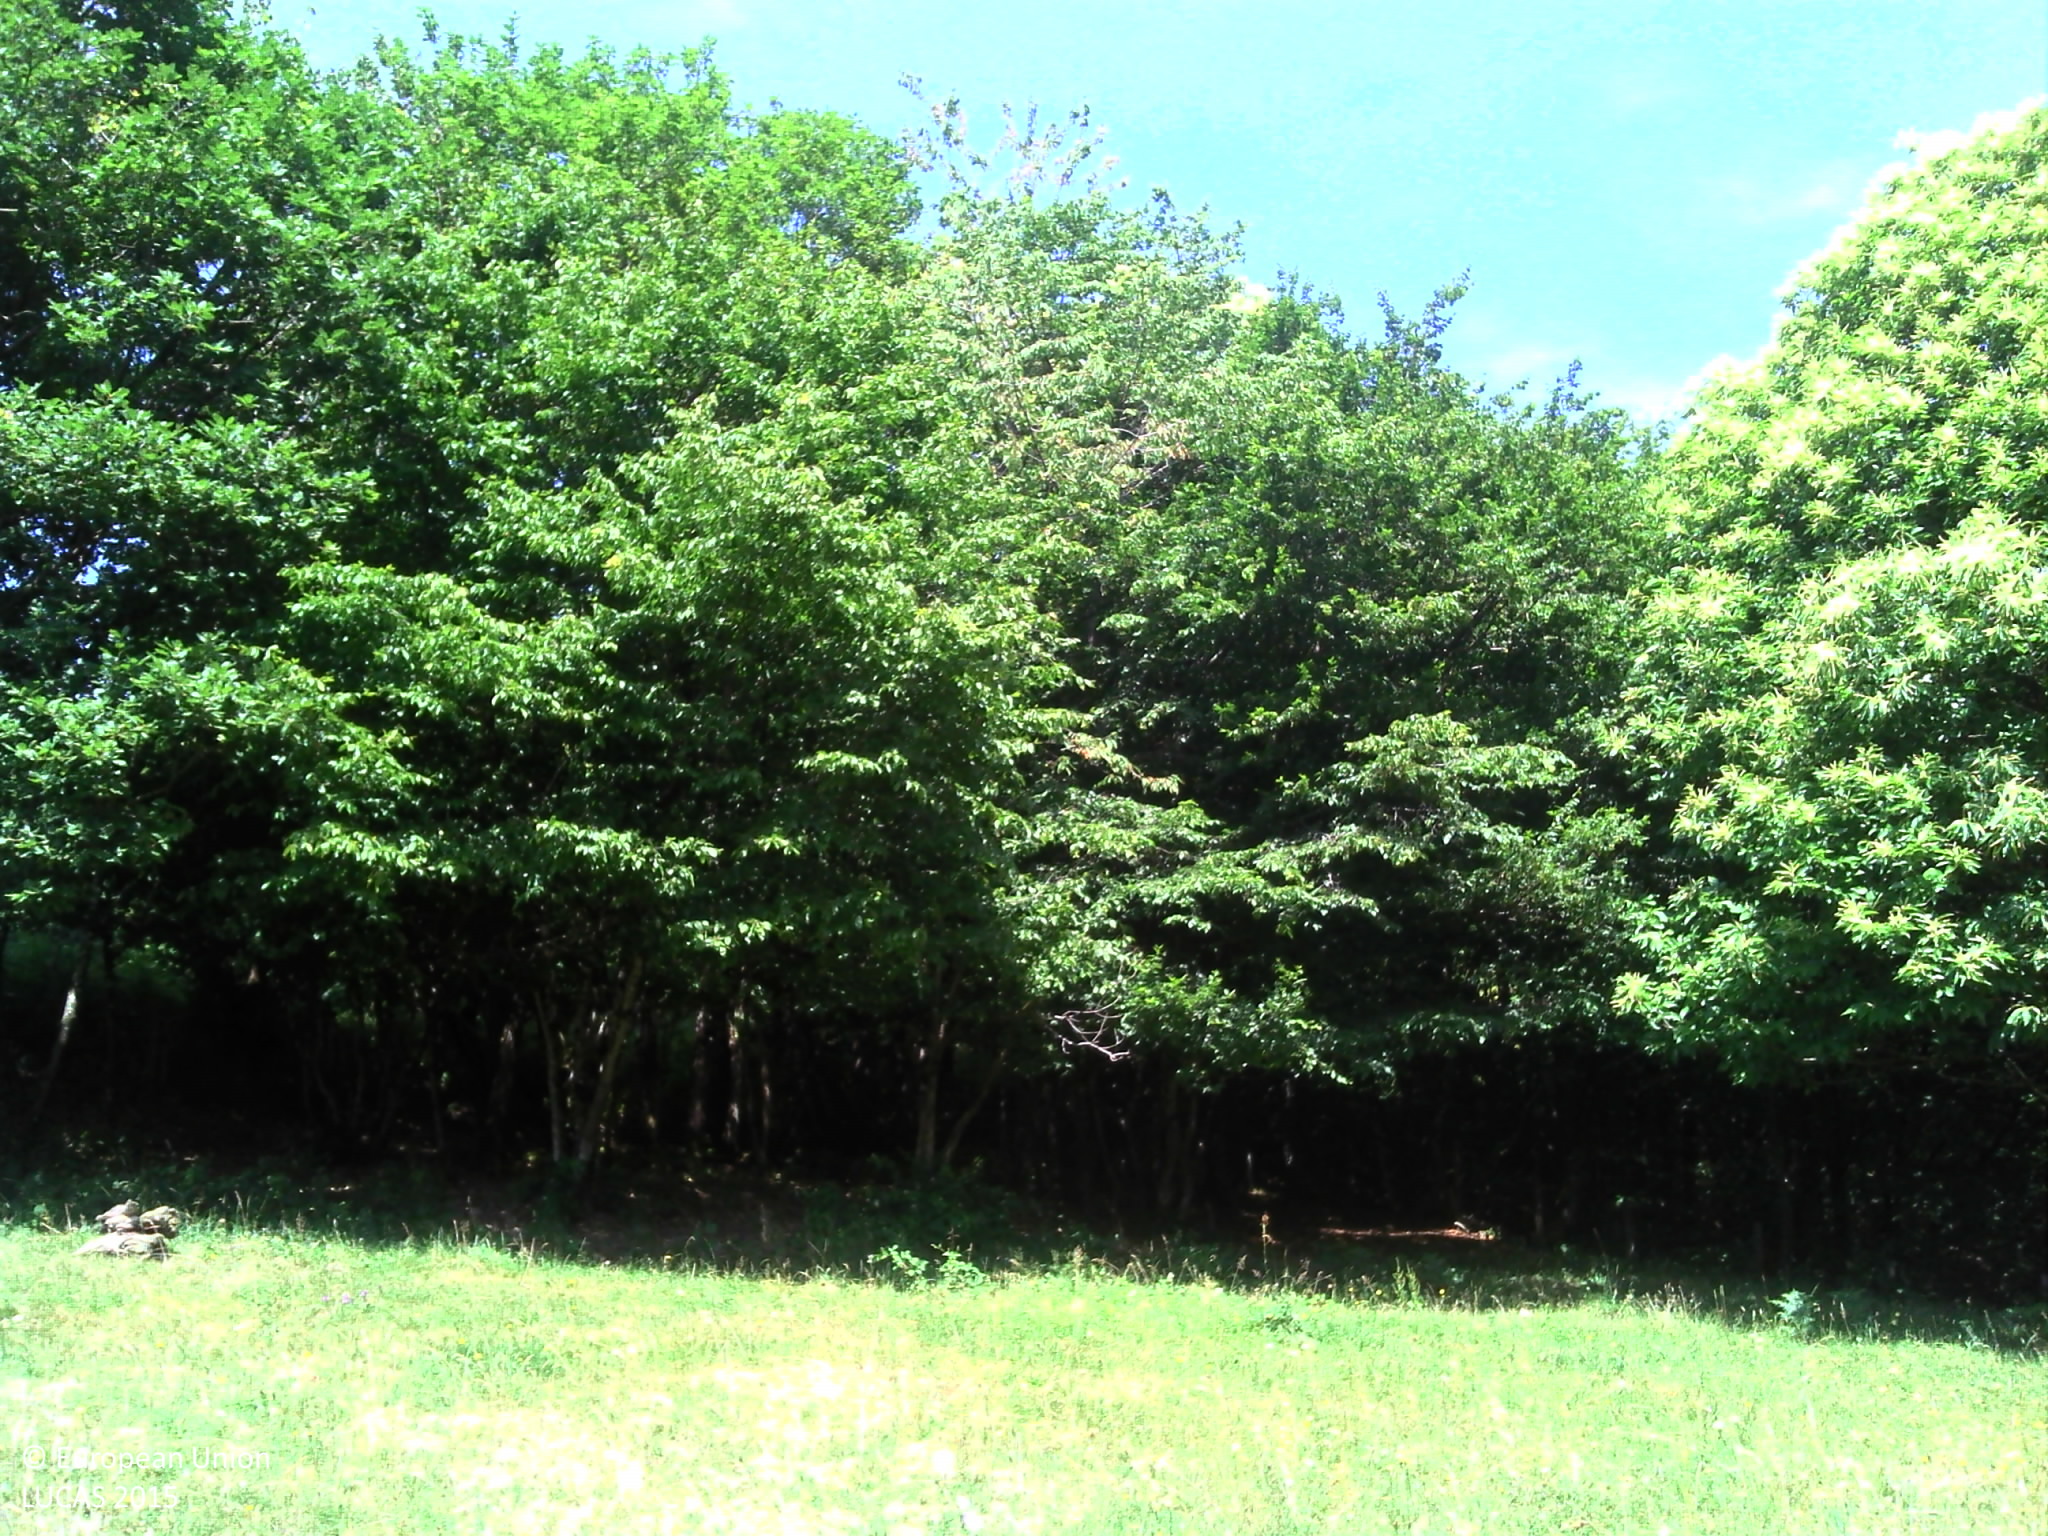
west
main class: Grassland
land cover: Grassland without tree/shrub cover
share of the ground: > 75 %
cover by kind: herbaceous plants 100 %
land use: Agriculture (excluding fallow land and kitchen gardens)
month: June
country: FR
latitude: 46.9230
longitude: 3.9977
